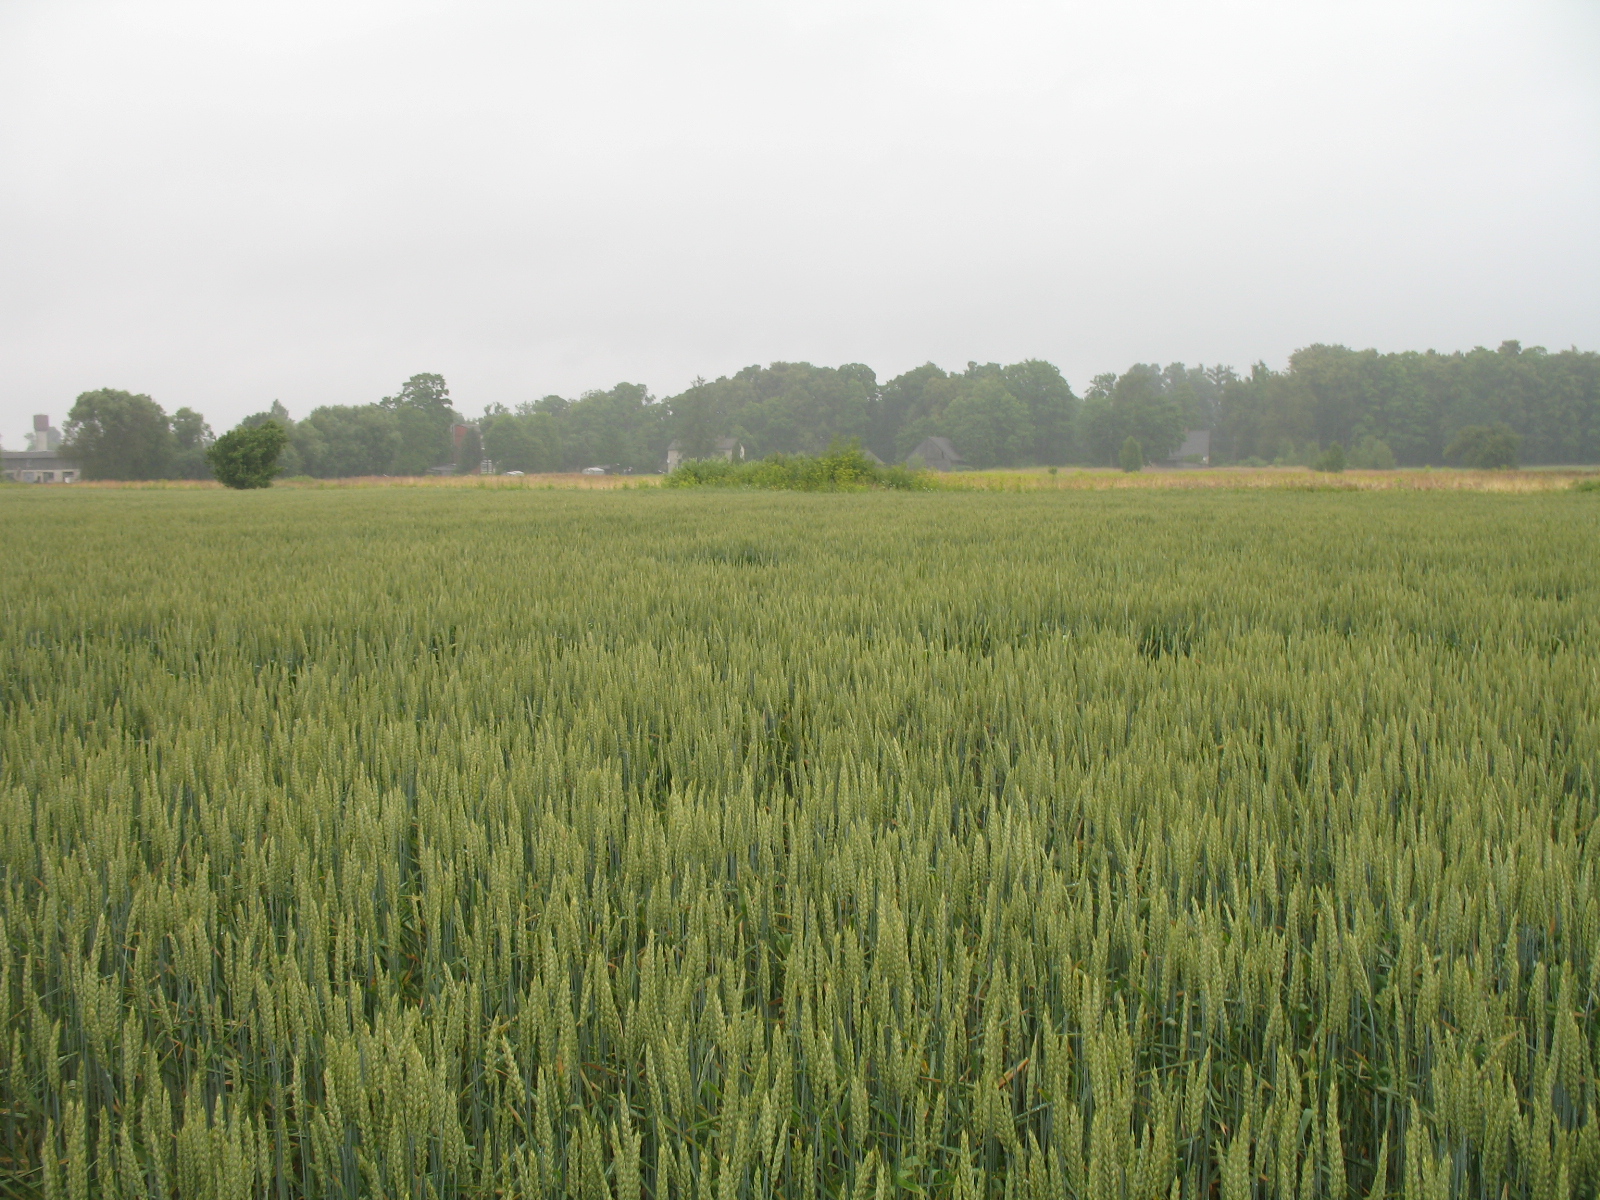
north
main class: Cropland
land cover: Common wheat
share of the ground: > 75 %
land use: Agriculture (excluding fallow land and kitchen gardens)
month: July
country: LV
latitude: 56.3600
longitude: 25.0157
